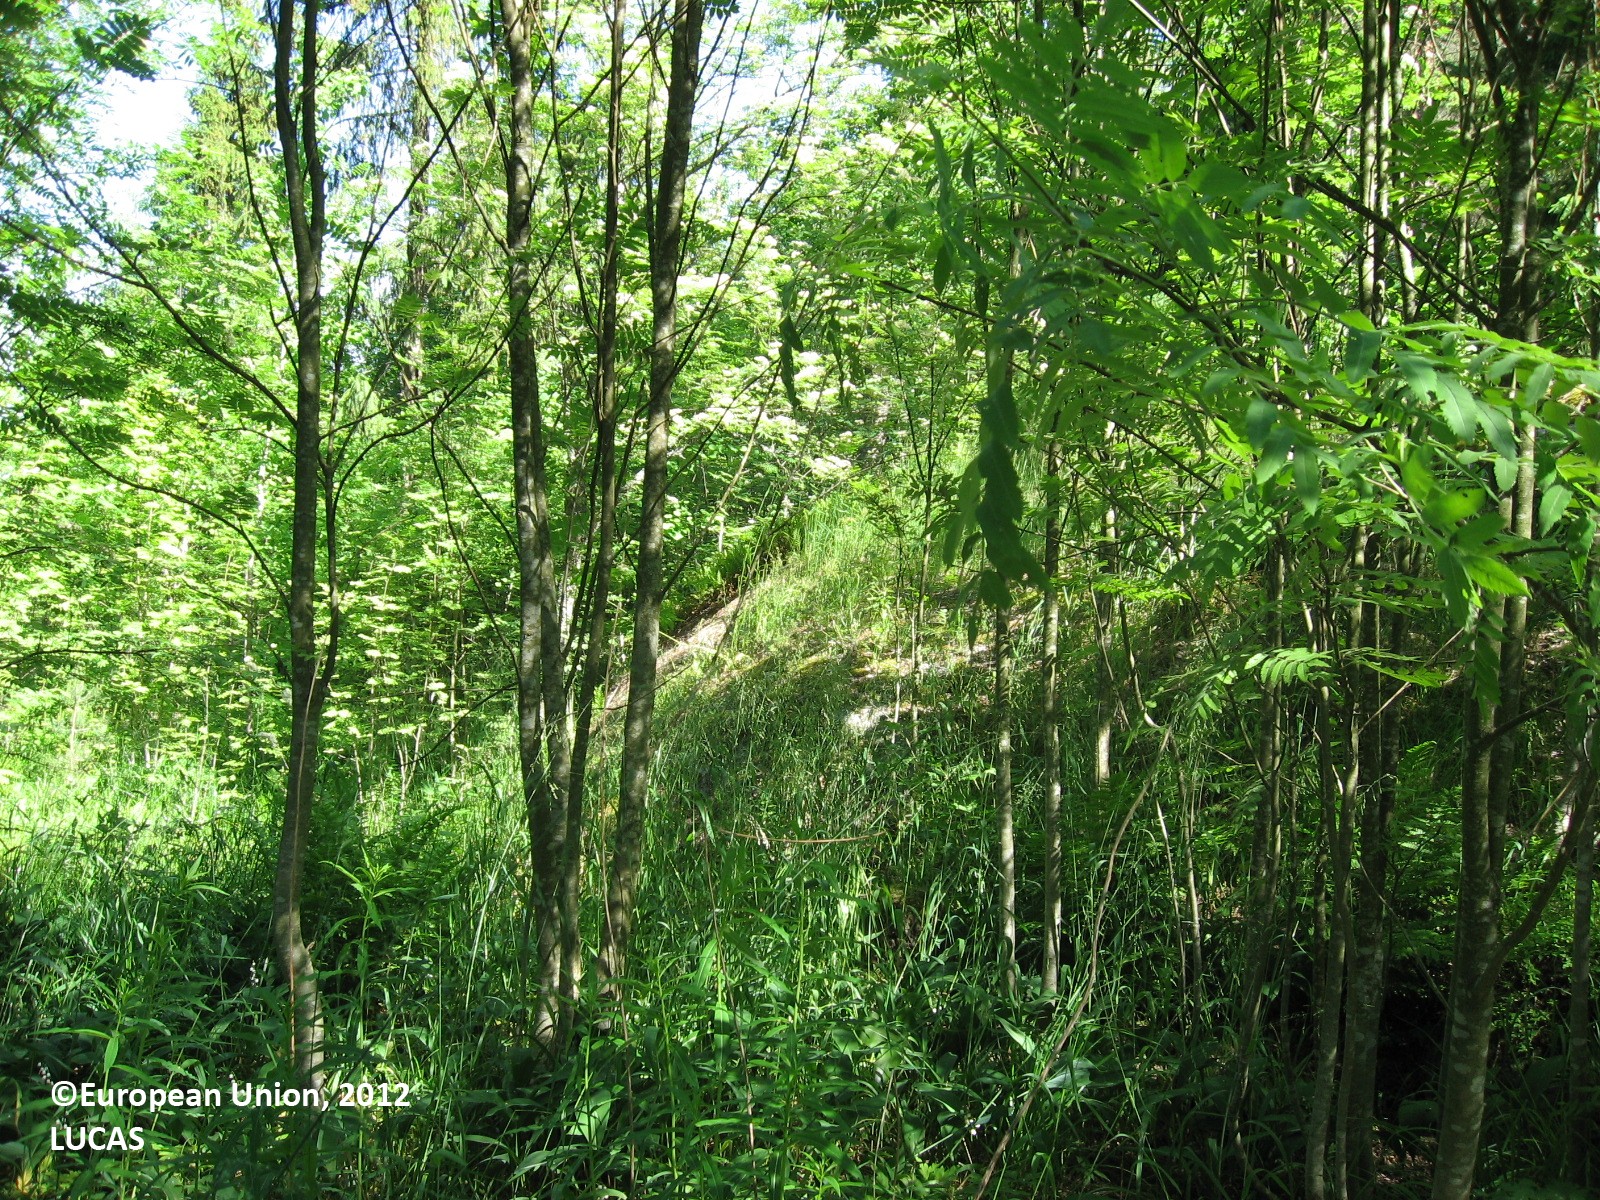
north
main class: Woodland
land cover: Spruce dominated mixed woodland
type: boreal forest
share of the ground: 50 - 75 %
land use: Forestry
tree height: > 5 m
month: June
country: FI
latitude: 60.5117
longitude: 24.9965
